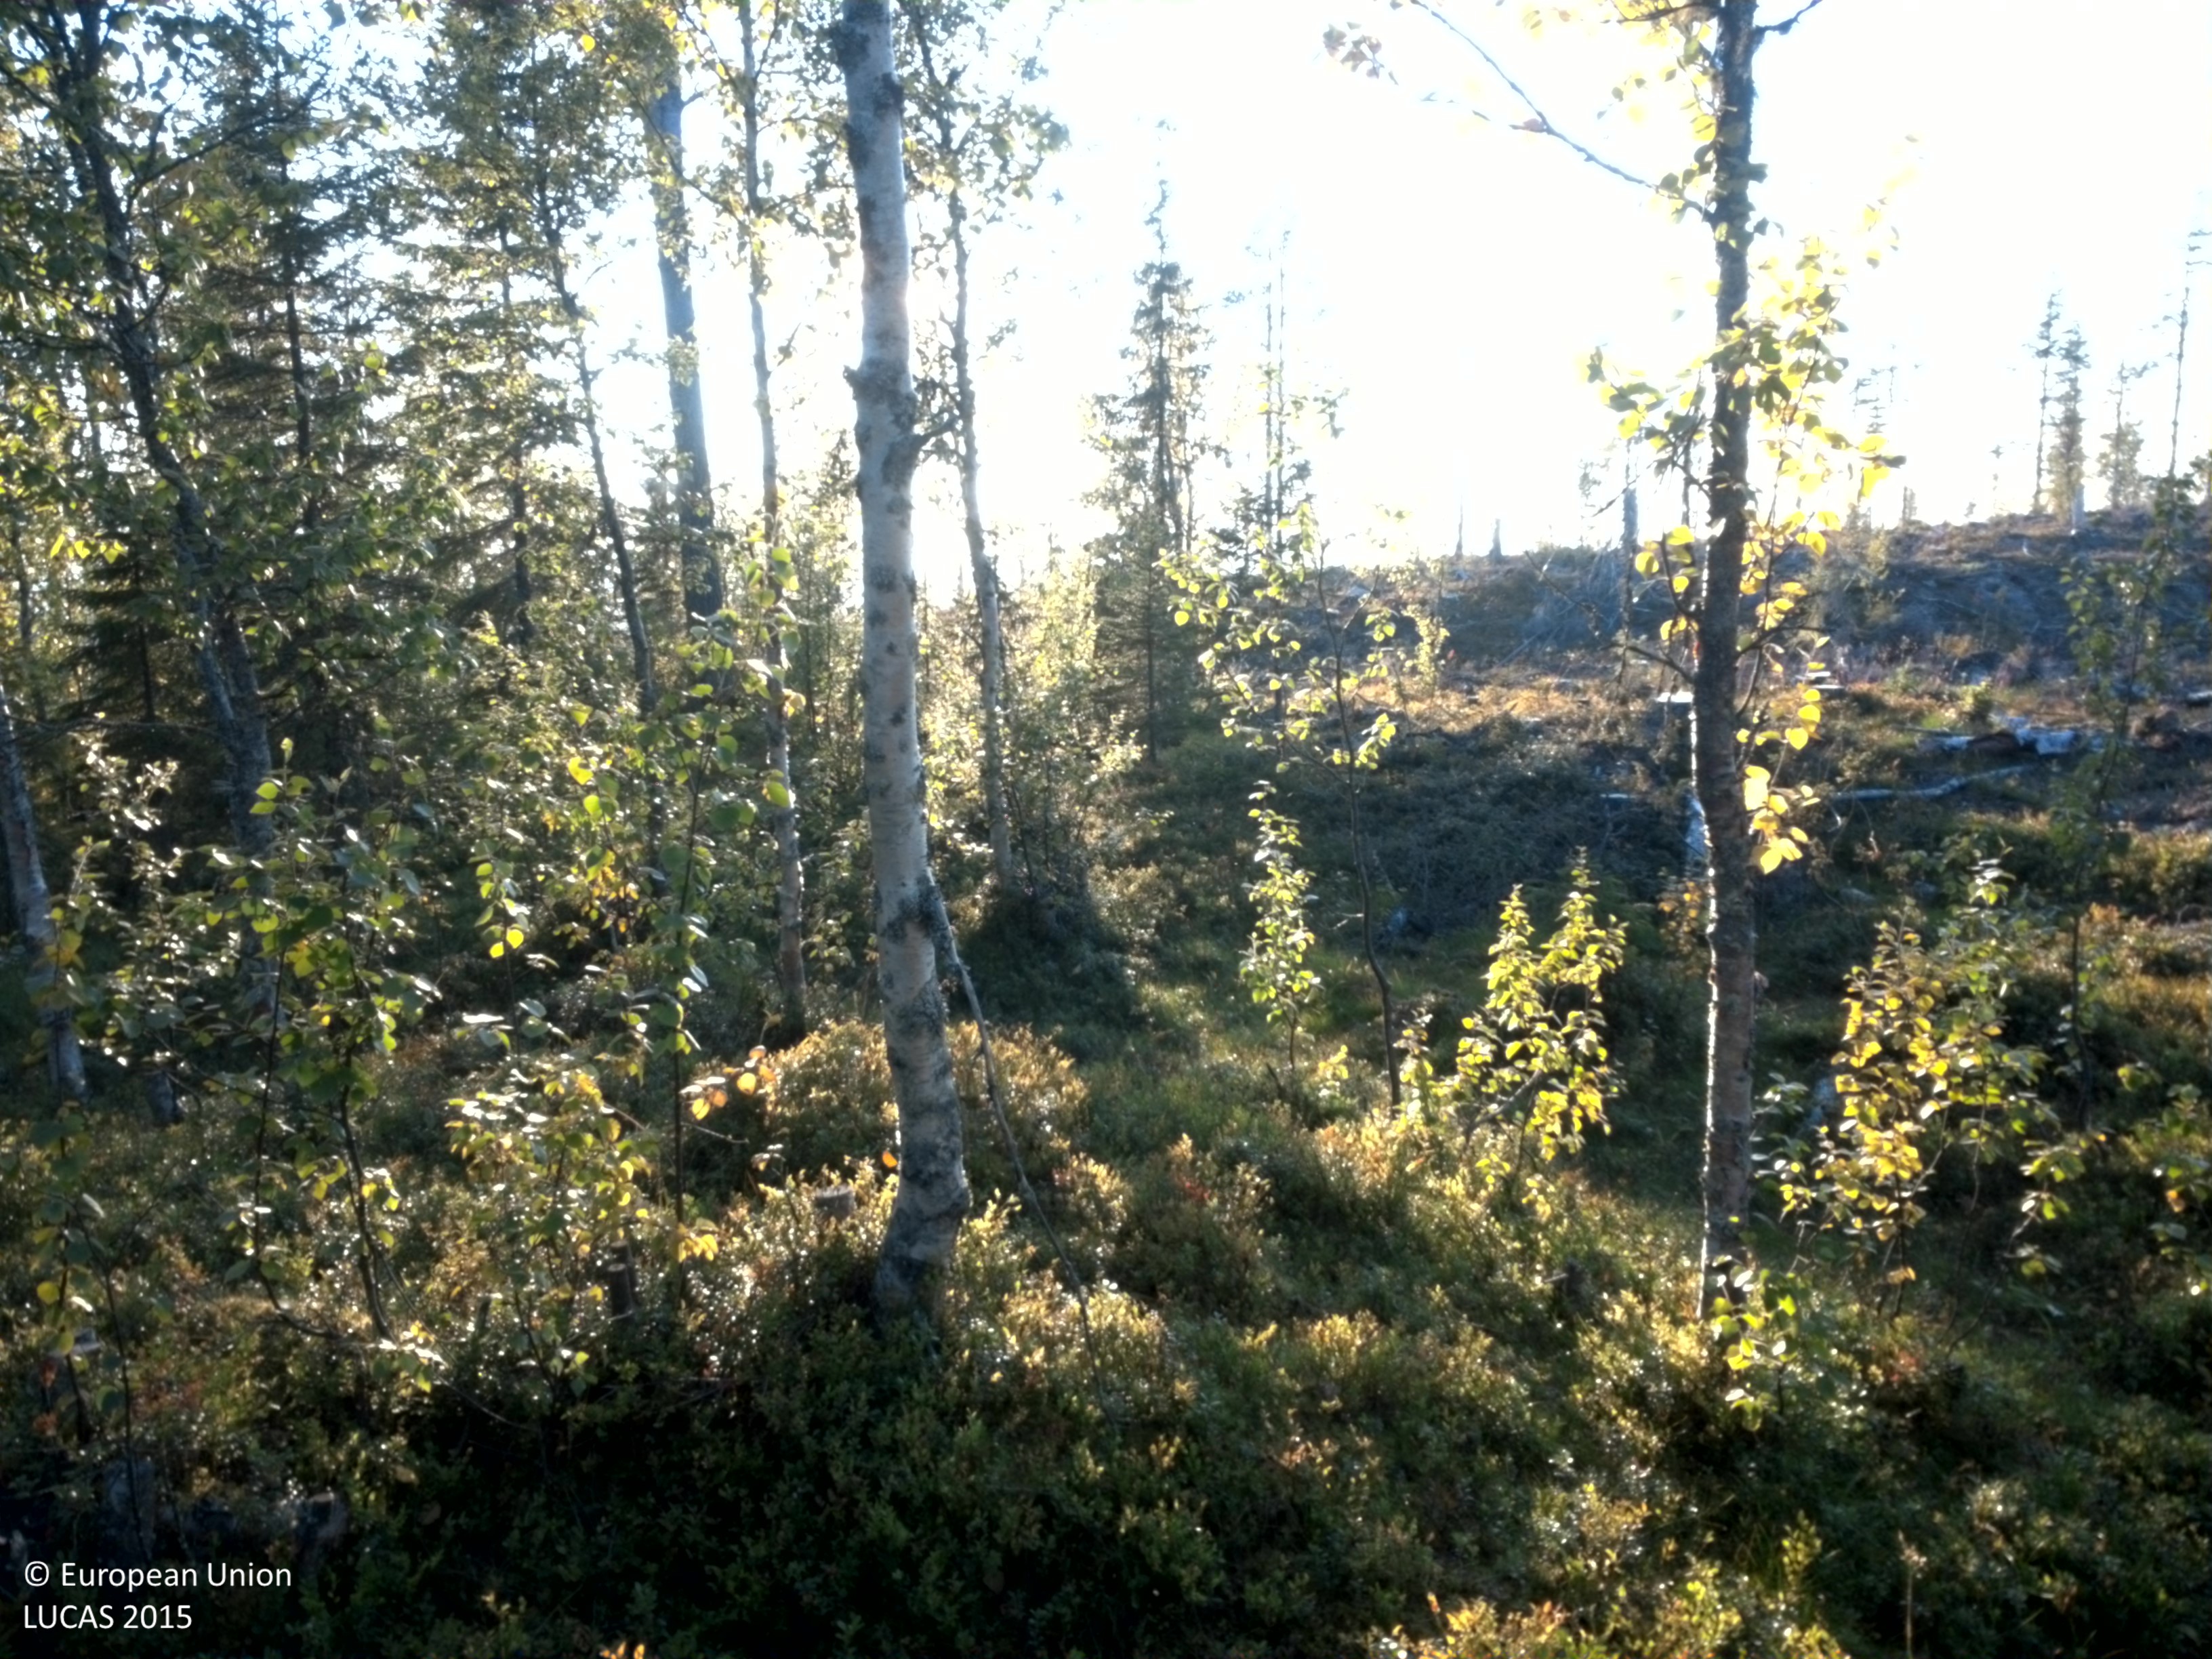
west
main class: Woodland
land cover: Spruce dominated mixed woodland
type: boreal forest
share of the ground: 25 - 50 %
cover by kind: shrubs 45 %, coniferous forest trees 15 %, broadleaved forest trees 15 %, herbaceous plants 15 %, lichens and mosses 10 %
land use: Forestry
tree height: > 5 m
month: September
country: SE
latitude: 65.3043
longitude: 16.8050
